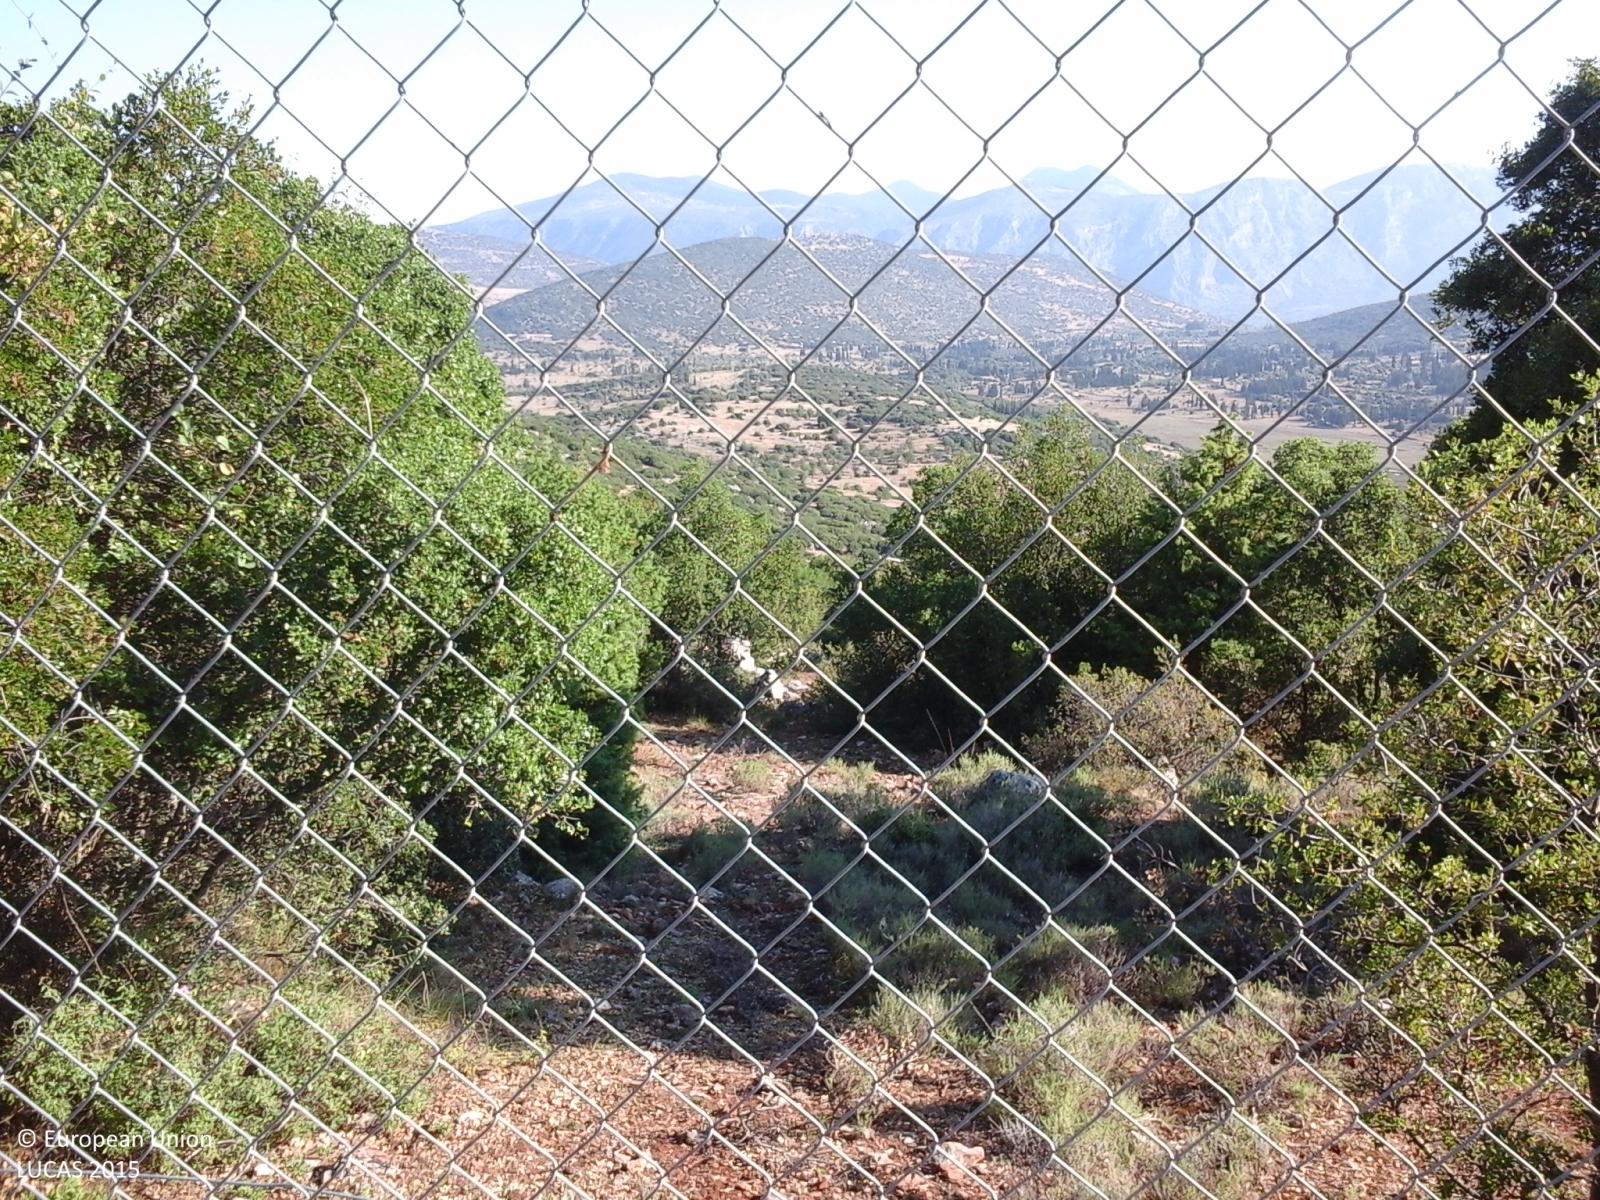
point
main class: Shrubland
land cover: Shrubland without tree cover
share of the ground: 50 - 75 %
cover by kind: shrubs 60 %, herbaceous plants 20 %, unconsolidated bare surface 20 %
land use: Agriculture (excluding fallow land and kitchen gardens)
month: June
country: GR
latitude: 38.4193
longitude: 22.5169
